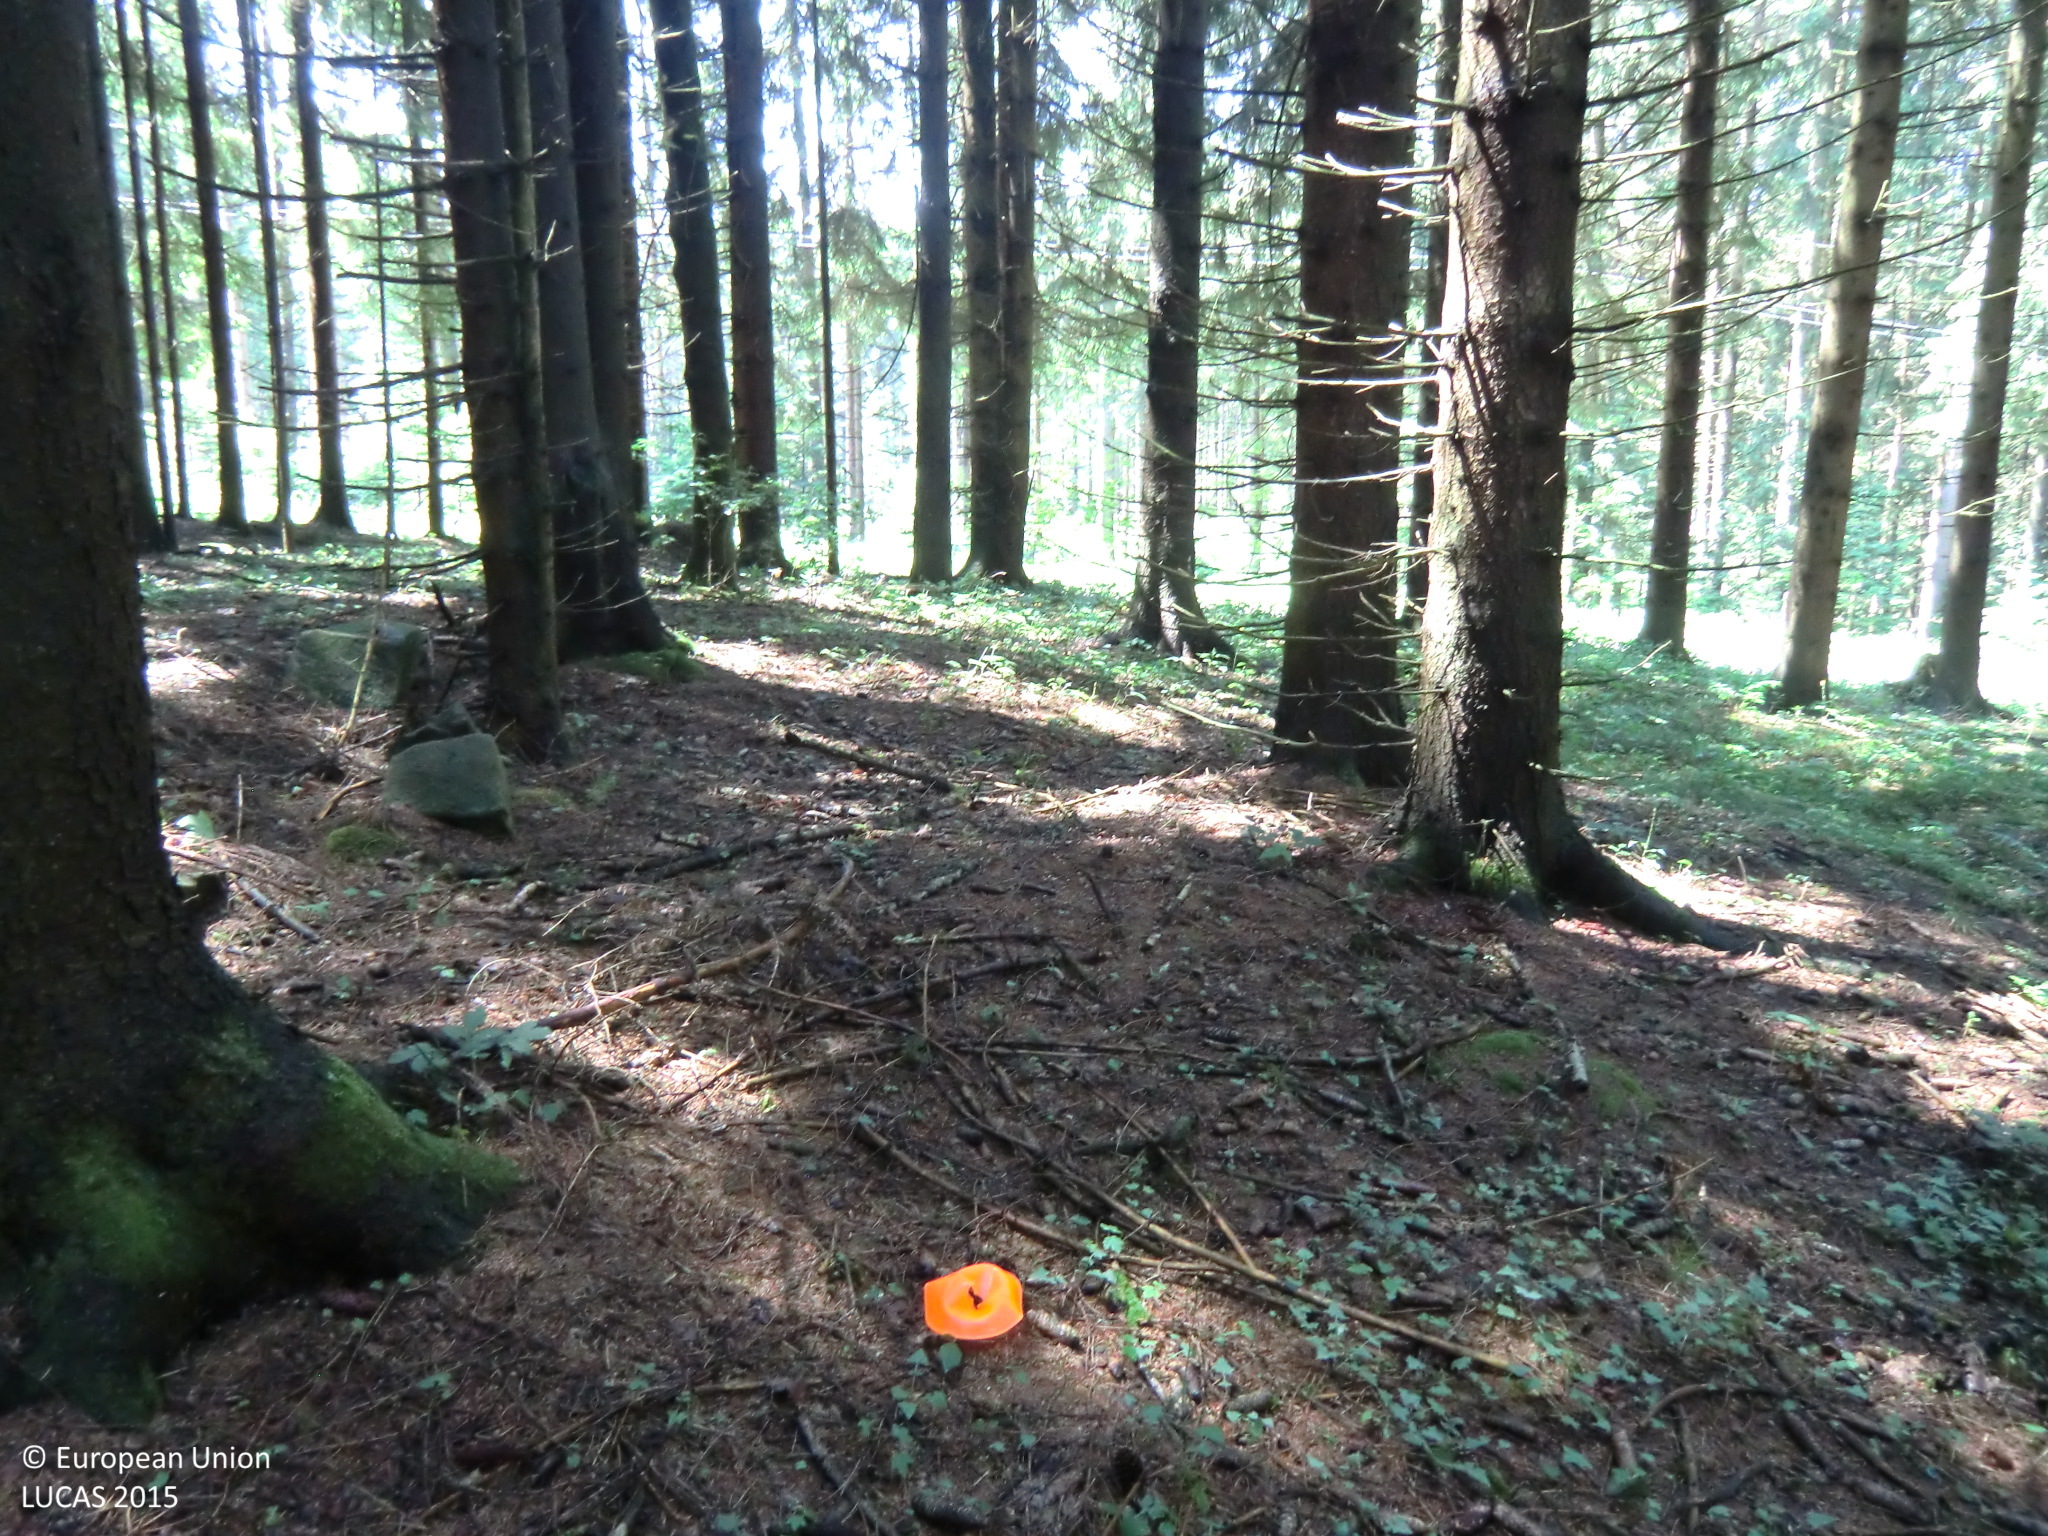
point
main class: Woodland
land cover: Spruce dominated coniferous woodland
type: hemiboreal forest and nemoral coniferous forest and mixed broadleaved-coniferous forest
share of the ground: > 75 %
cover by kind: coniferous forest trees 90 %, herbaceous plants 5 %, unconsolidated bare surface 5 %
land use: Forestry
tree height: > 5 m
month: June
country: AT
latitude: 48.5603
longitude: 14.5943
